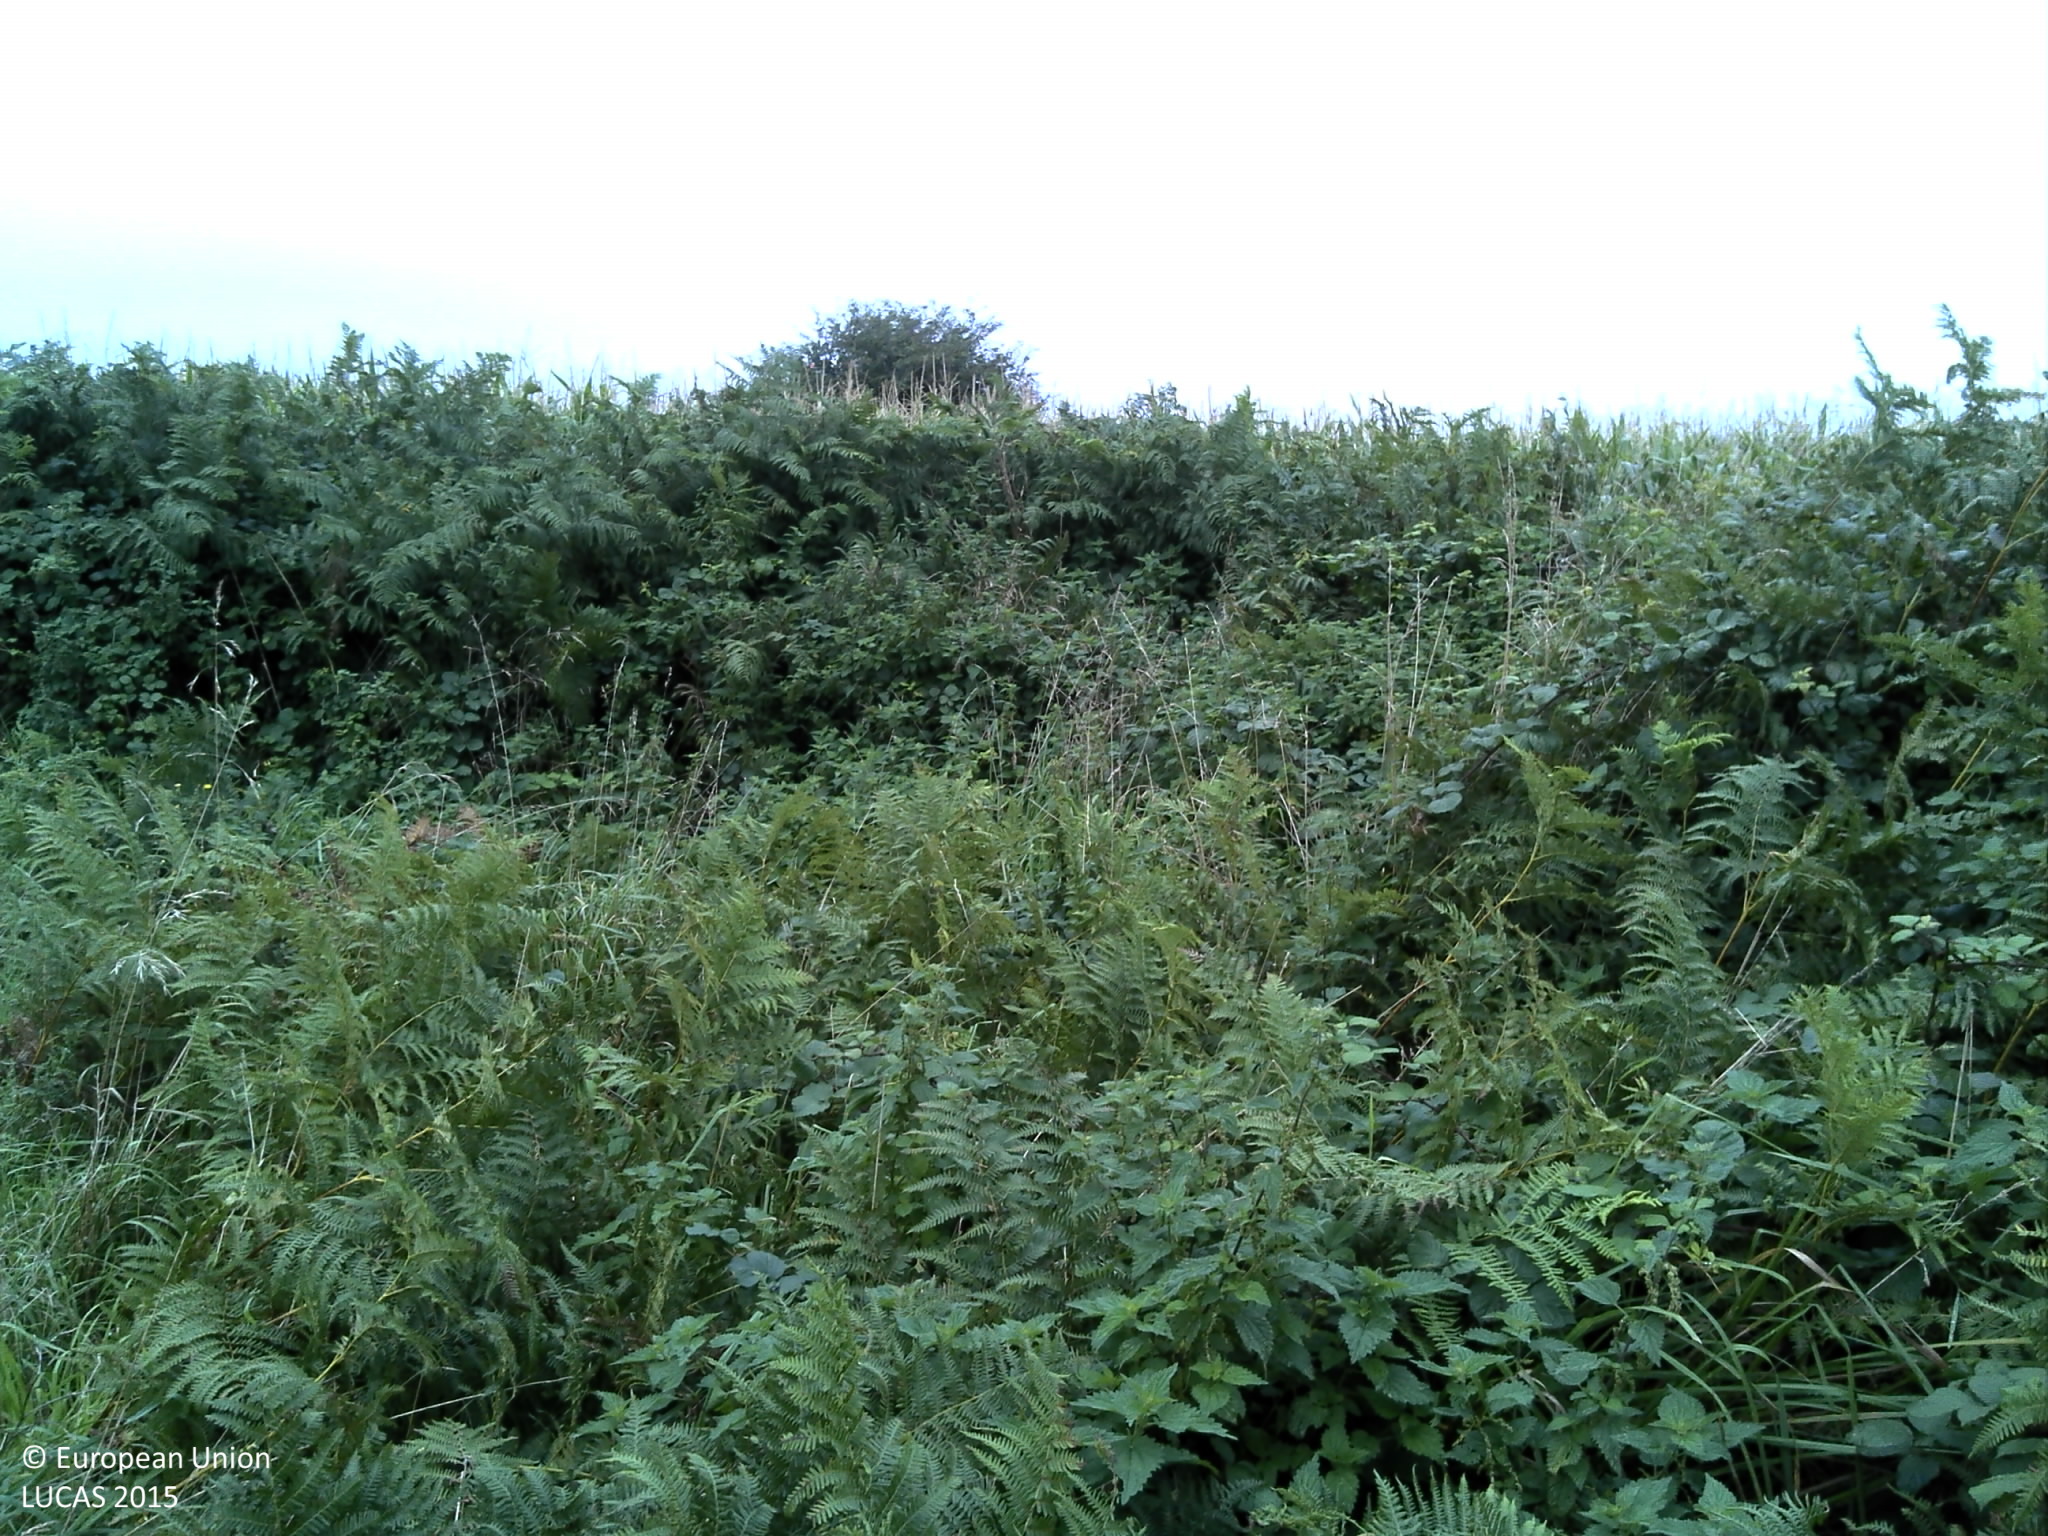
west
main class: Cropland
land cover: Maize
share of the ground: > 75 %
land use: Agriculture (excluding fallow land and kitchen gardens)
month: August
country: FR
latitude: 48.6085
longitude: -4.2399
